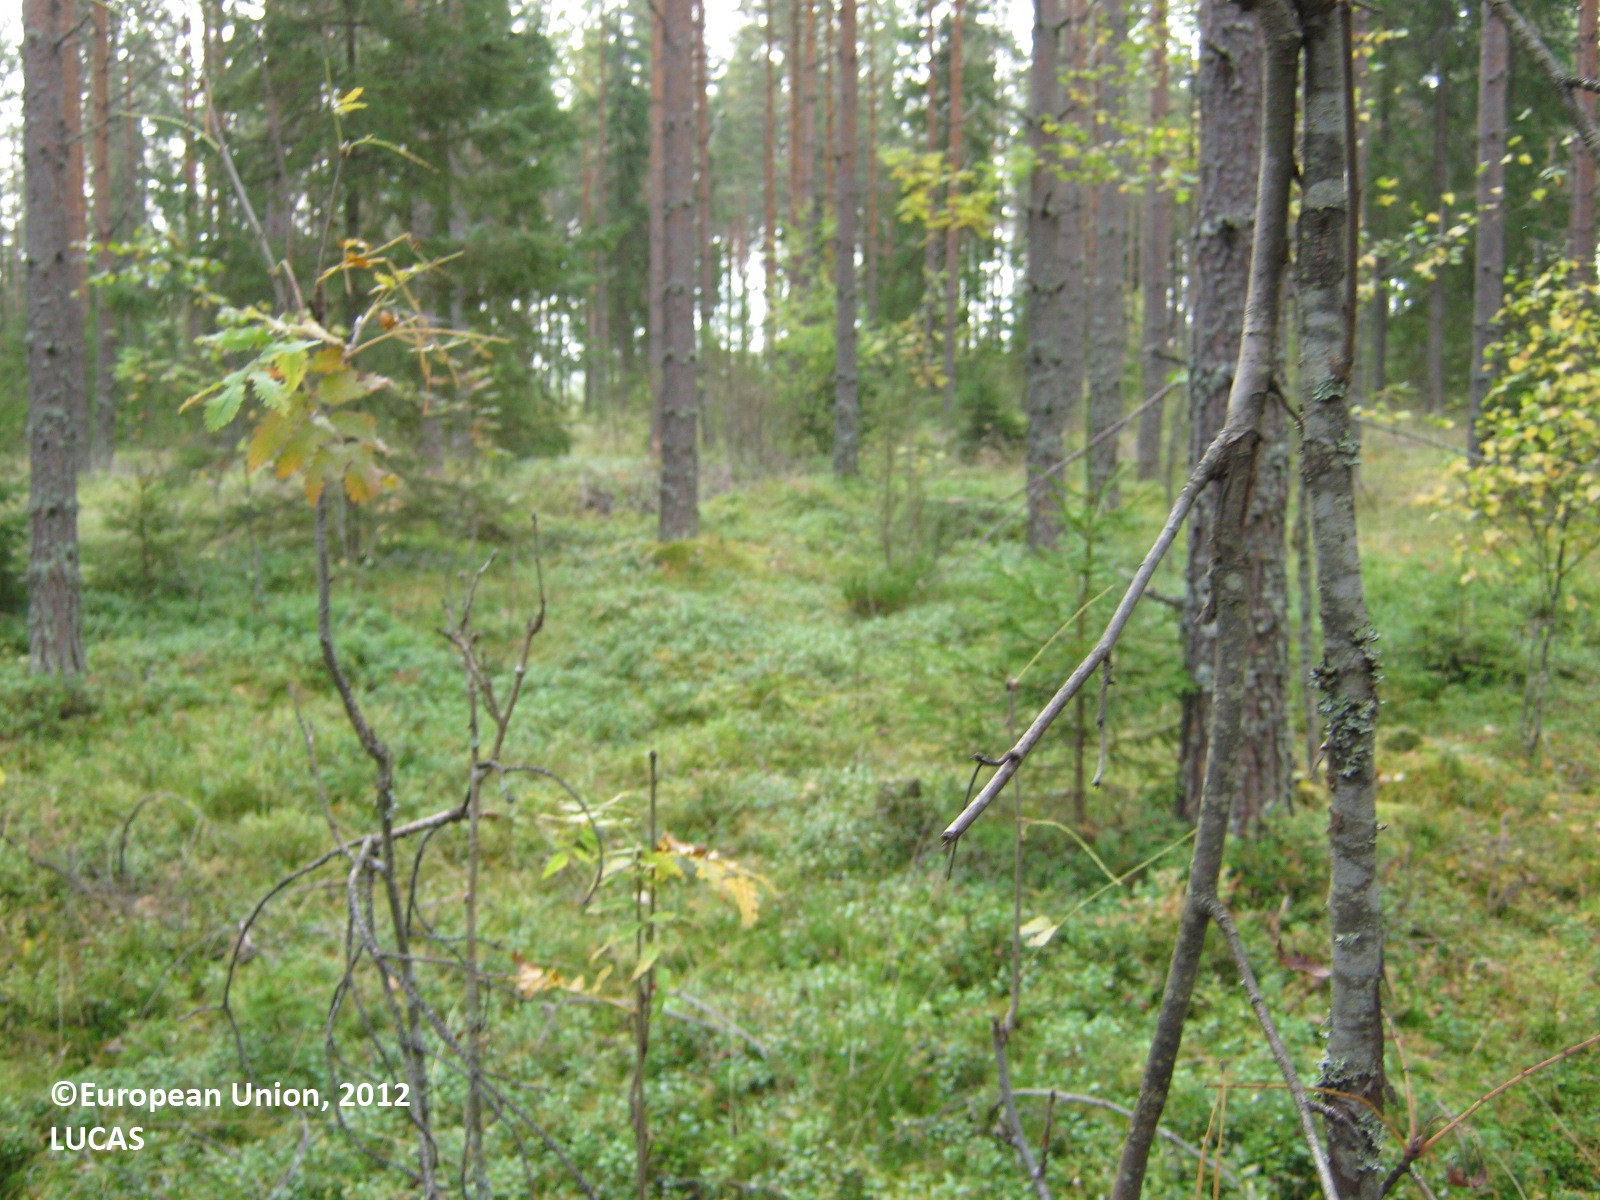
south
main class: Woodland
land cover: Pine dominated coniferous woodland
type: boreal forest
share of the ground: 50 - 75 %
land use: Forestry
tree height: > 5 m
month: September
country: FI
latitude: 60.8525
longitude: 28.0747
